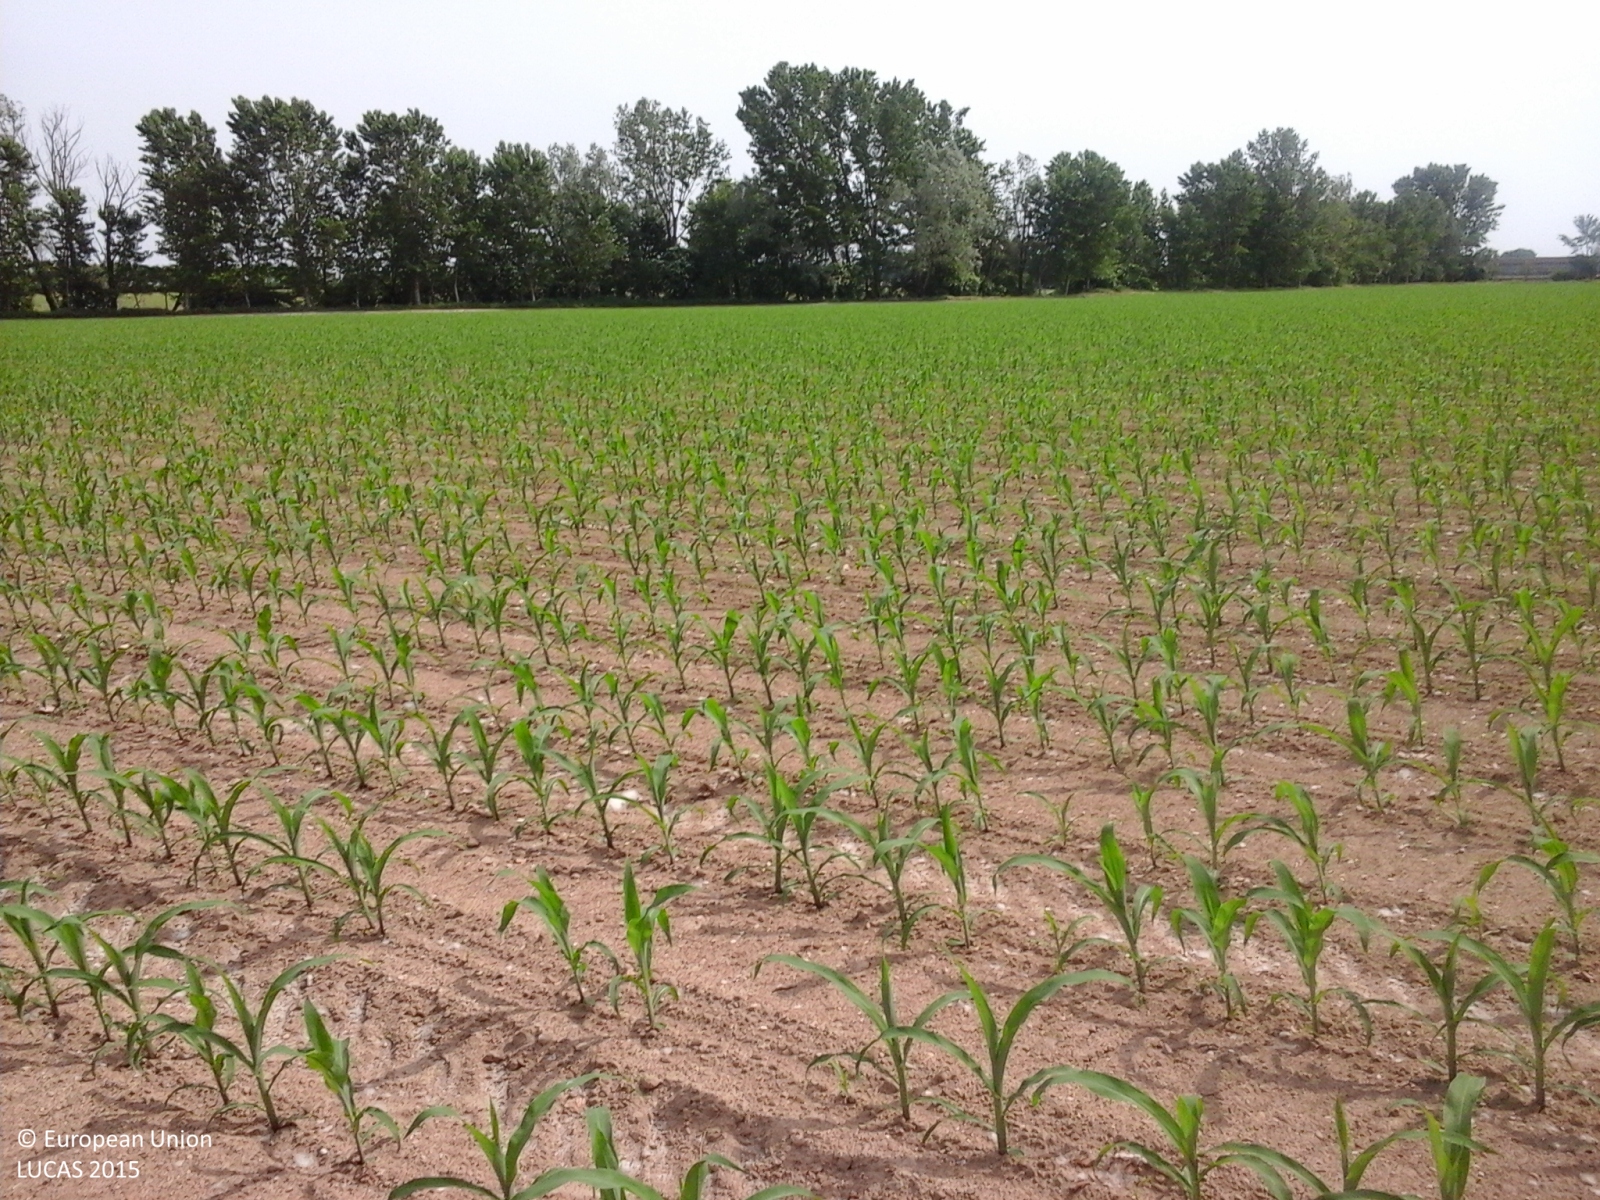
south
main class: Cropland
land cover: Maize
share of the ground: 25 - 50 %
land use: Agriculture (excluding fallow land and kitchen gardens)
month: May
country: IT
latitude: 45.2881
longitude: 10.0636
